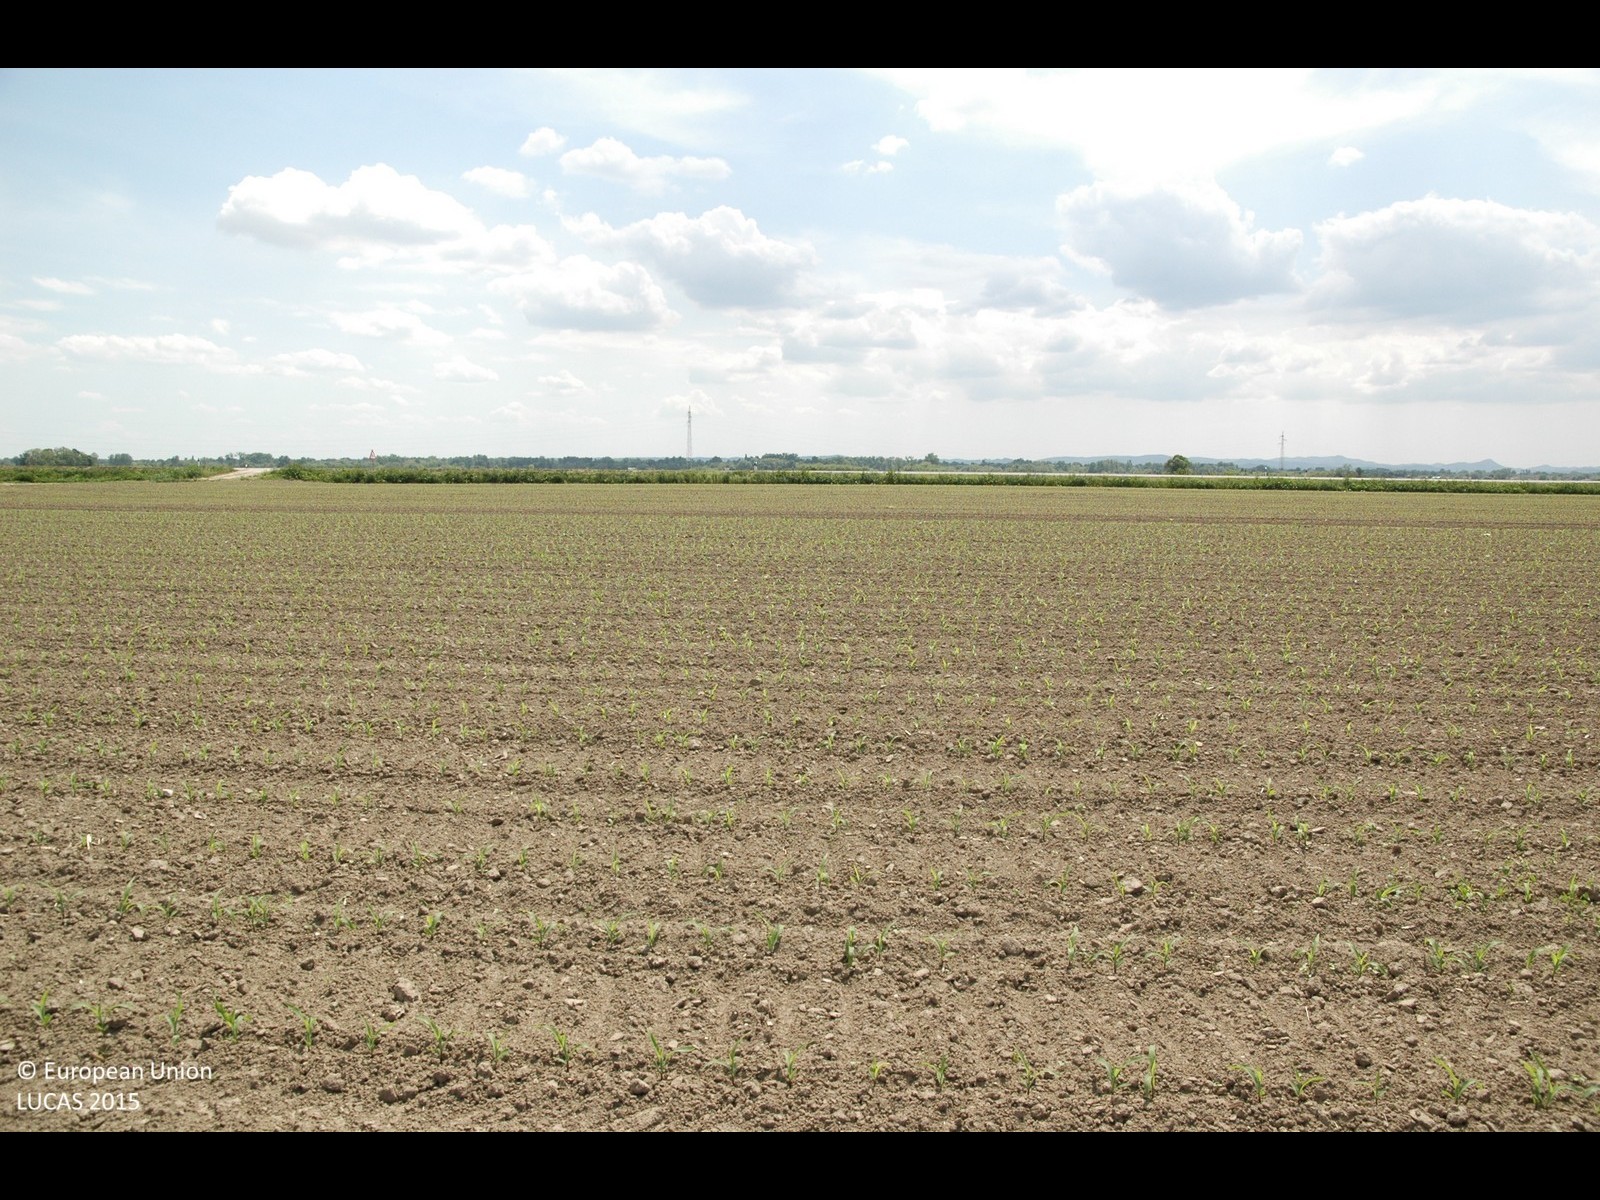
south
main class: Cropland
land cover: Maize
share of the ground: > 75 %
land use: Agriculture (excluding fallow land and kitchen gardens)
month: May
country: HR
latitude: 46.3483
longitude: 16.5630
